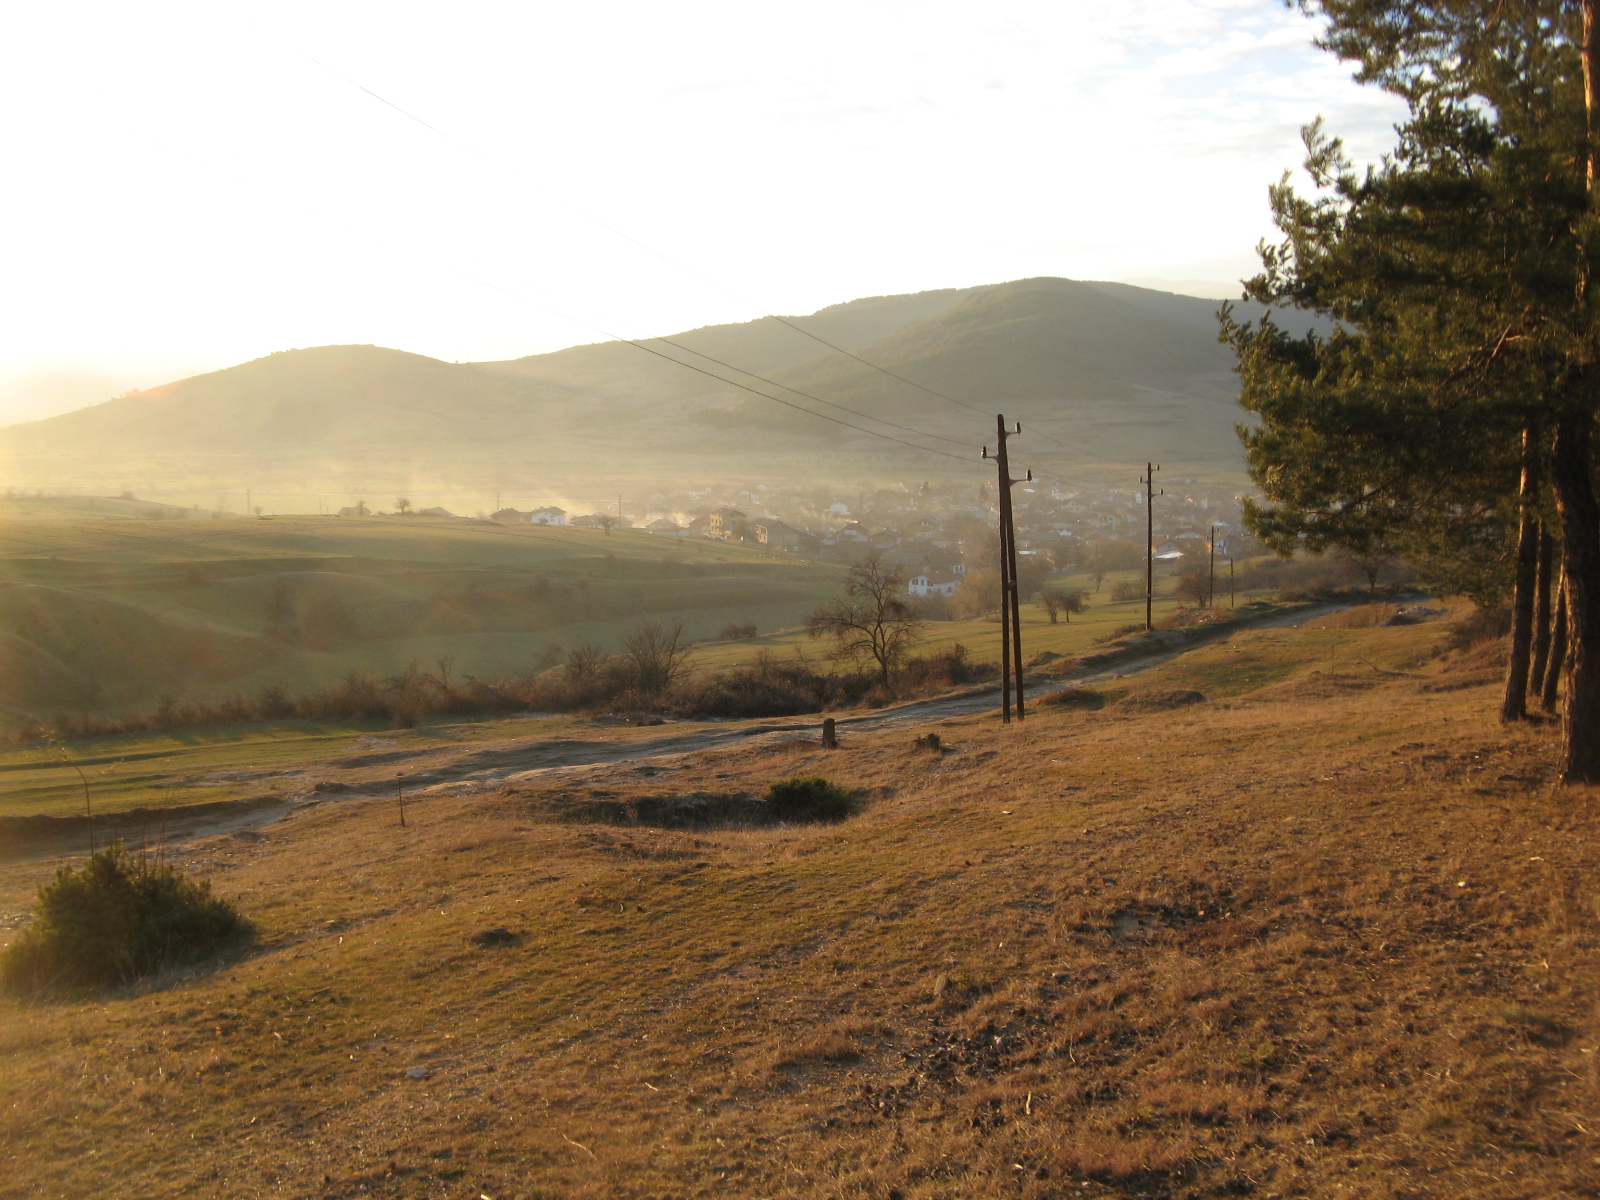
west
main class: Woodland
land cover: Pine dominated coniferous woodland
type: hemiboreal forest and nemoral coniferous forest and mixed broadleaved-coniferous forest
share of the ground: > 75 %
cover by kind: coniferous forest trees 90 %, herbaceous plants 5 %, unconsolidated bare surface 5 %
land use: Forestry
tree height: > 5 m
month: December
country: BG
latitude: 42.0411
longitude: 24.1379
